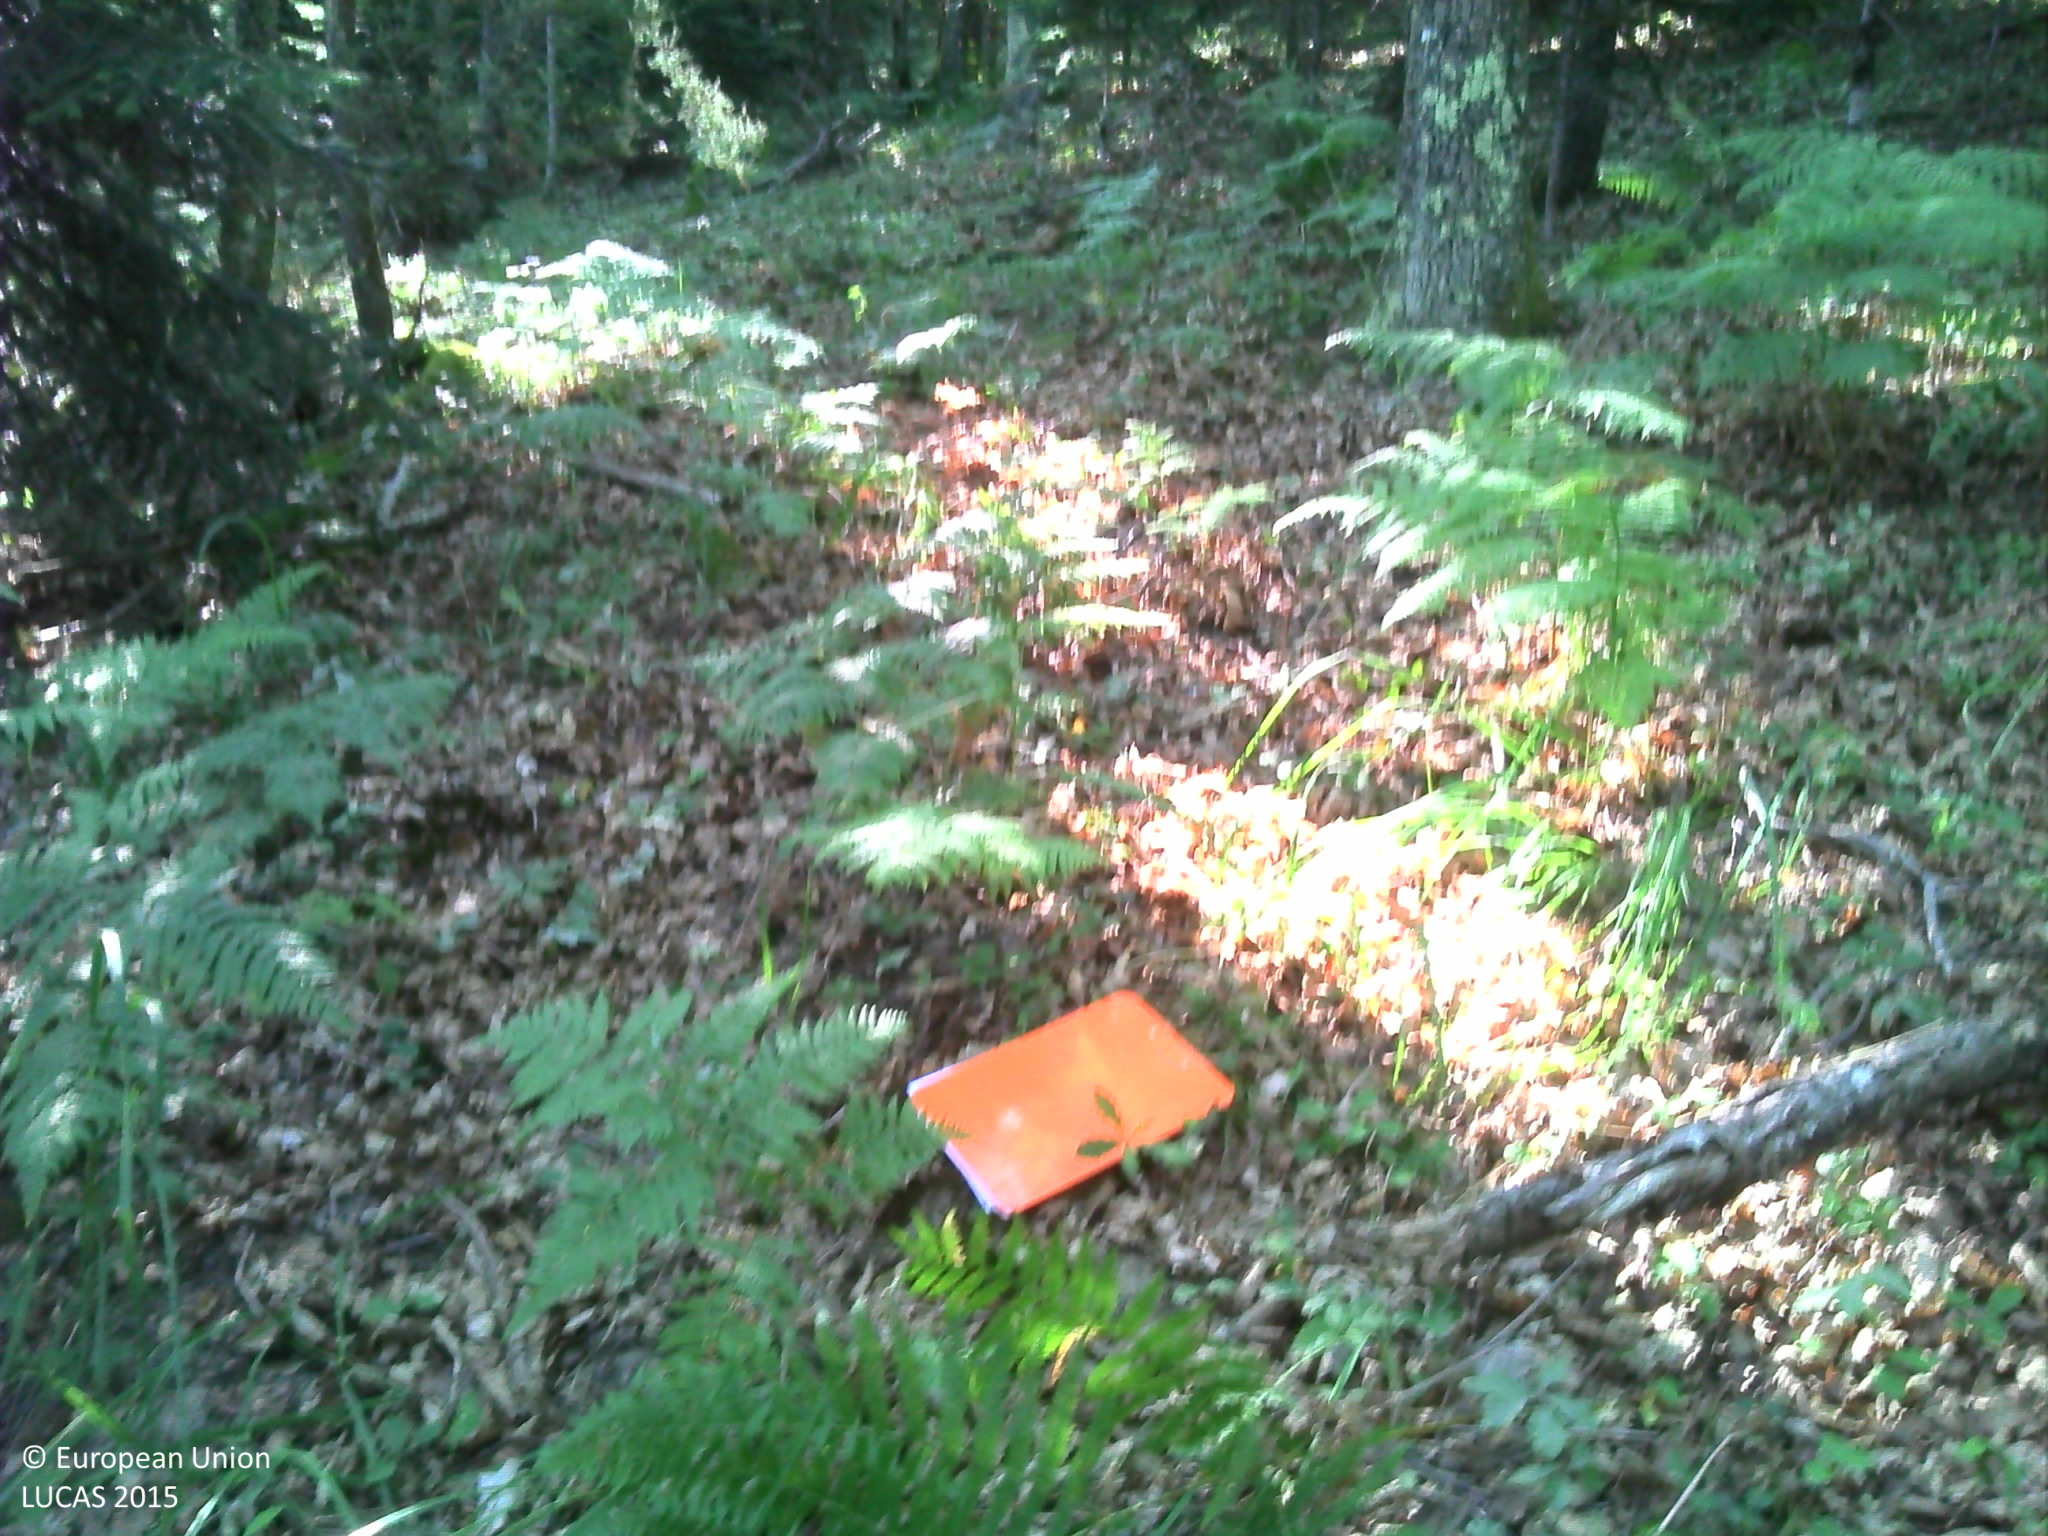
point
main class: Woodland
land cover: Broadleaved woodland
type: thermophilous deciduous forest
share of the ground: > 75 %
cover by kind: broadleaved forest trees 90 %, herbaceous plants 10 %
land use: Forestry
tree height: > 5 m
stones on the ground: < 10 %
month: July
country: FR
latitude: 42.9259
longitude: 2.1063
